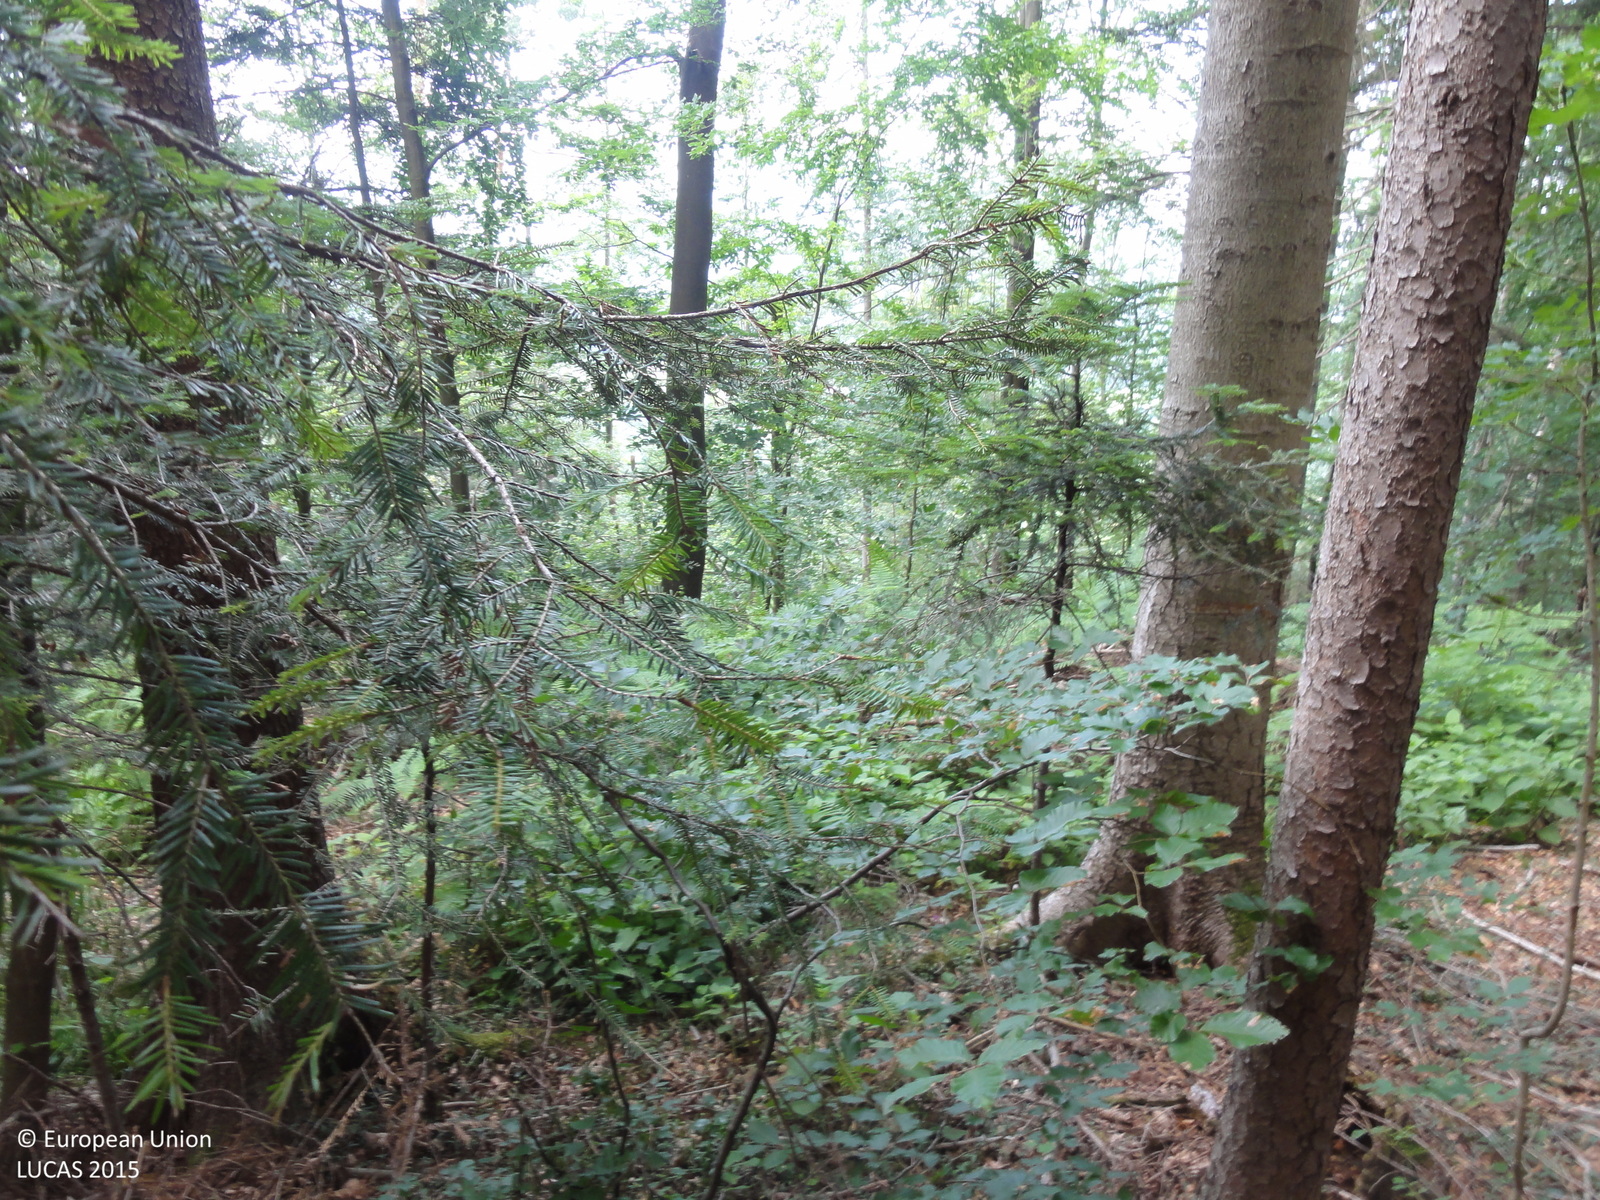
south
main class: Woodland
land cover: Spruce dominated mixed woodland
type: mountainous beech forest
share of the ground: > 75 %
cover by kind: coniferous forest trees 65 %, broadleaved forest trees 30 %, shrubs 5 %
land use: Forestry
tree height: > 5 m
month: June
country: SI
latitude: 46.3306
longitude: 14.8686
